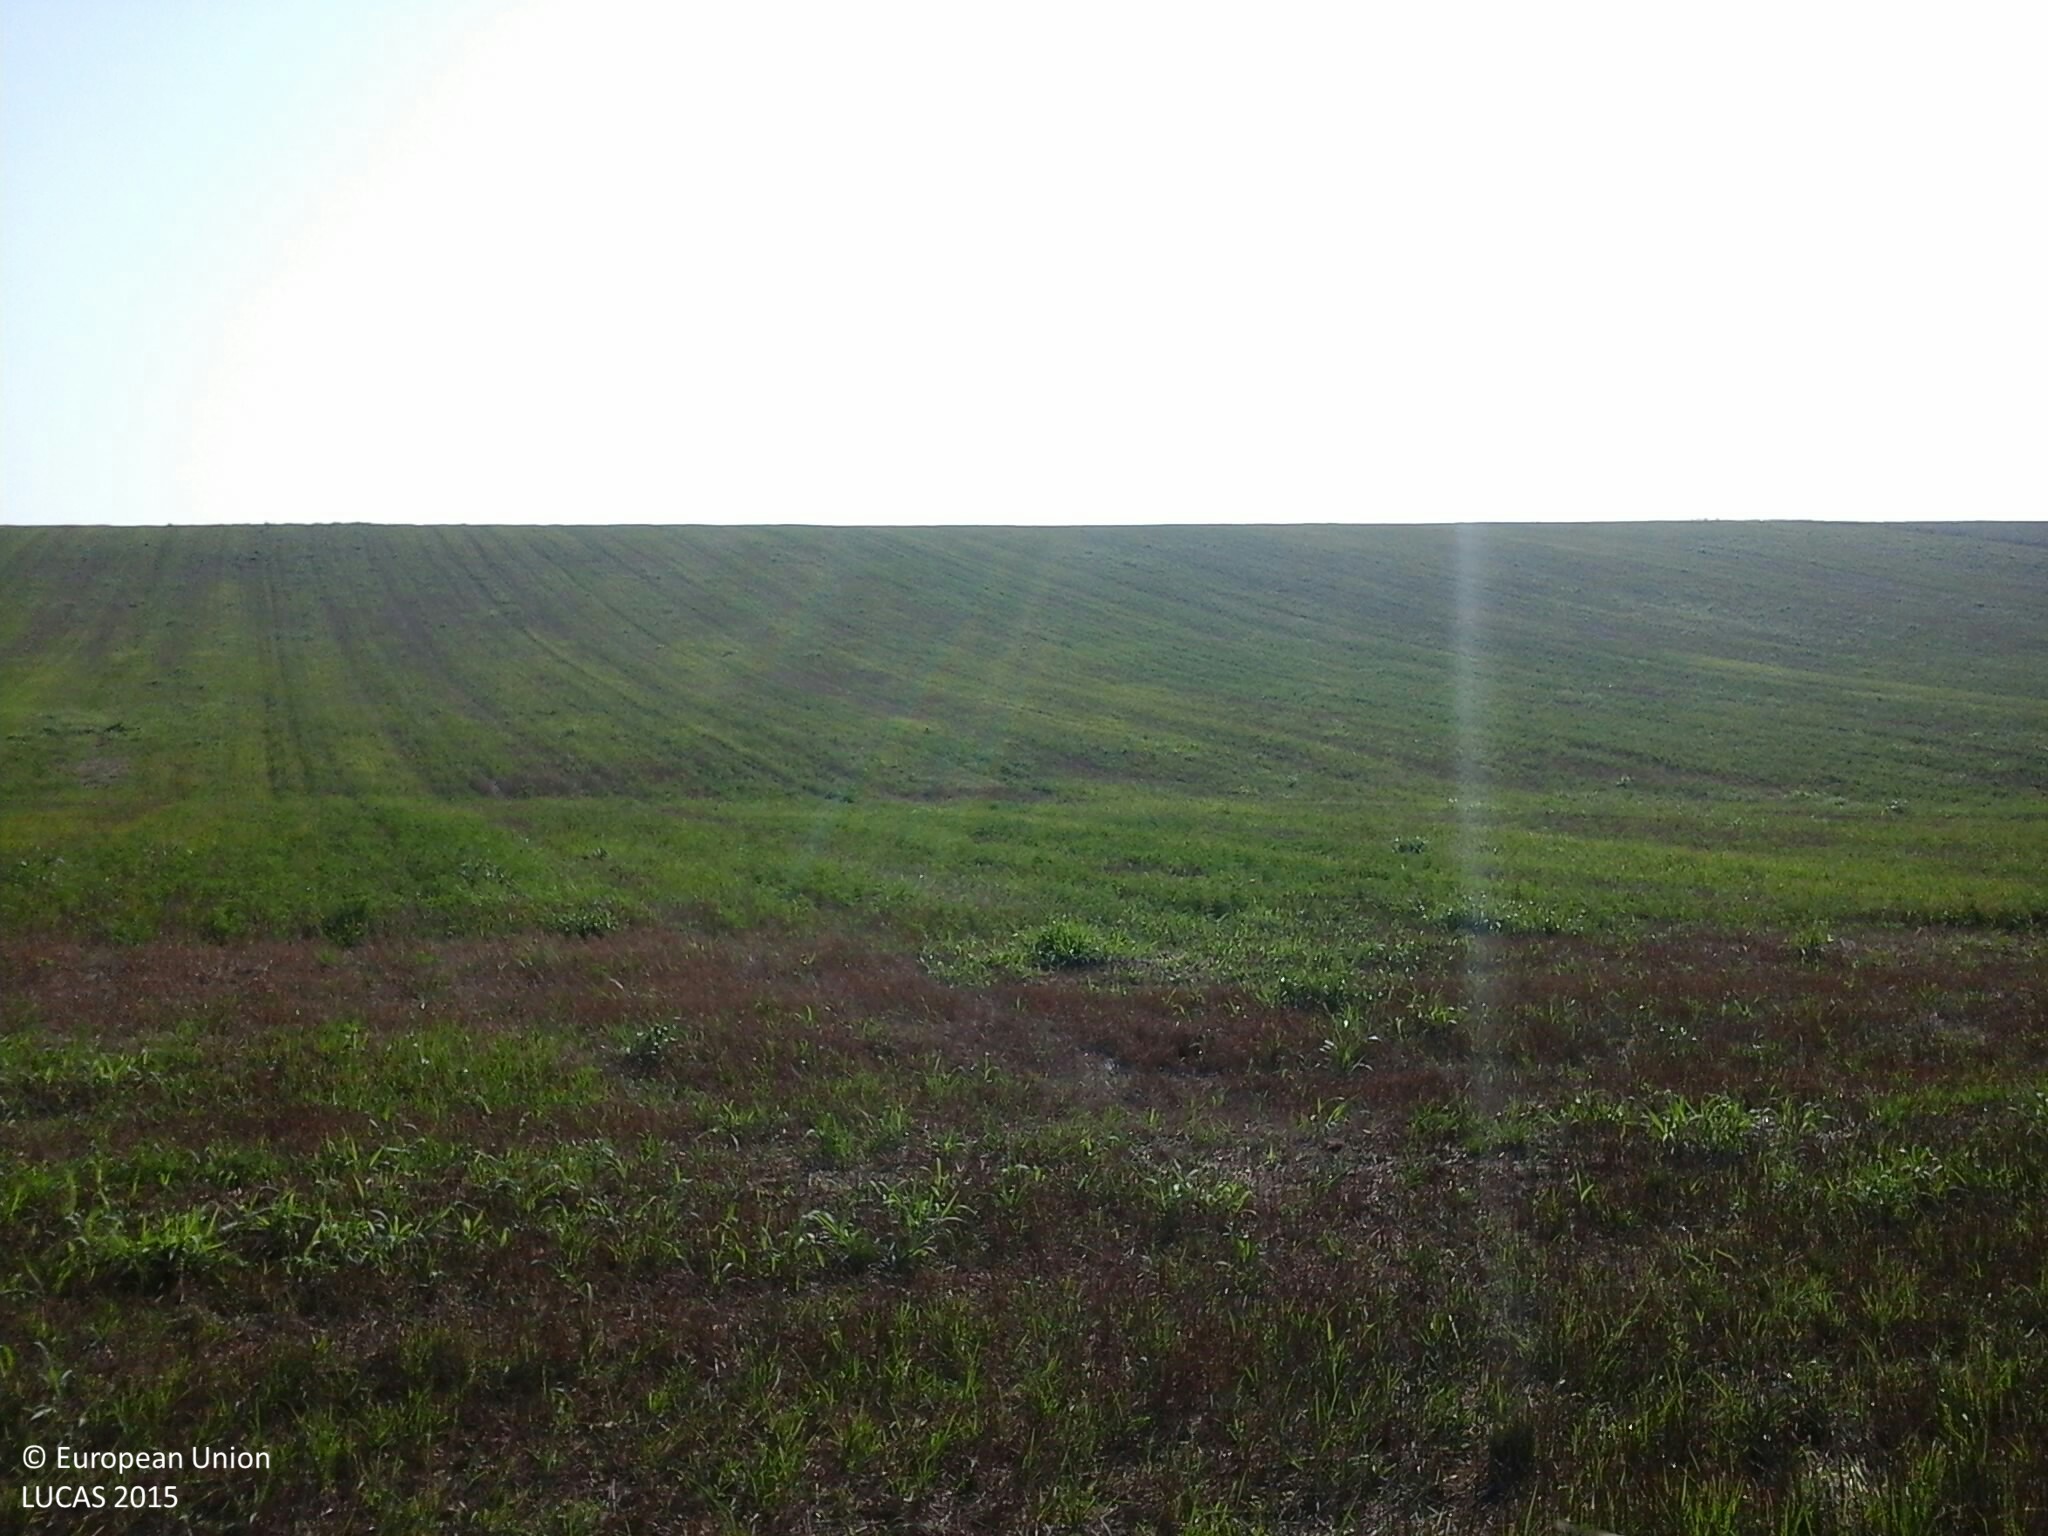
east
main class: Cropland
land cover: Sunflower
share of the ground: > 75 %
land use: Agriculture (excluding fallow land and kitchen gardens)
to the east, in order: Sunflower; Tracks; Barley; Rape and turnip rape
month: August
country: HU
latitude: 46.6074
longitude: 18.0637
